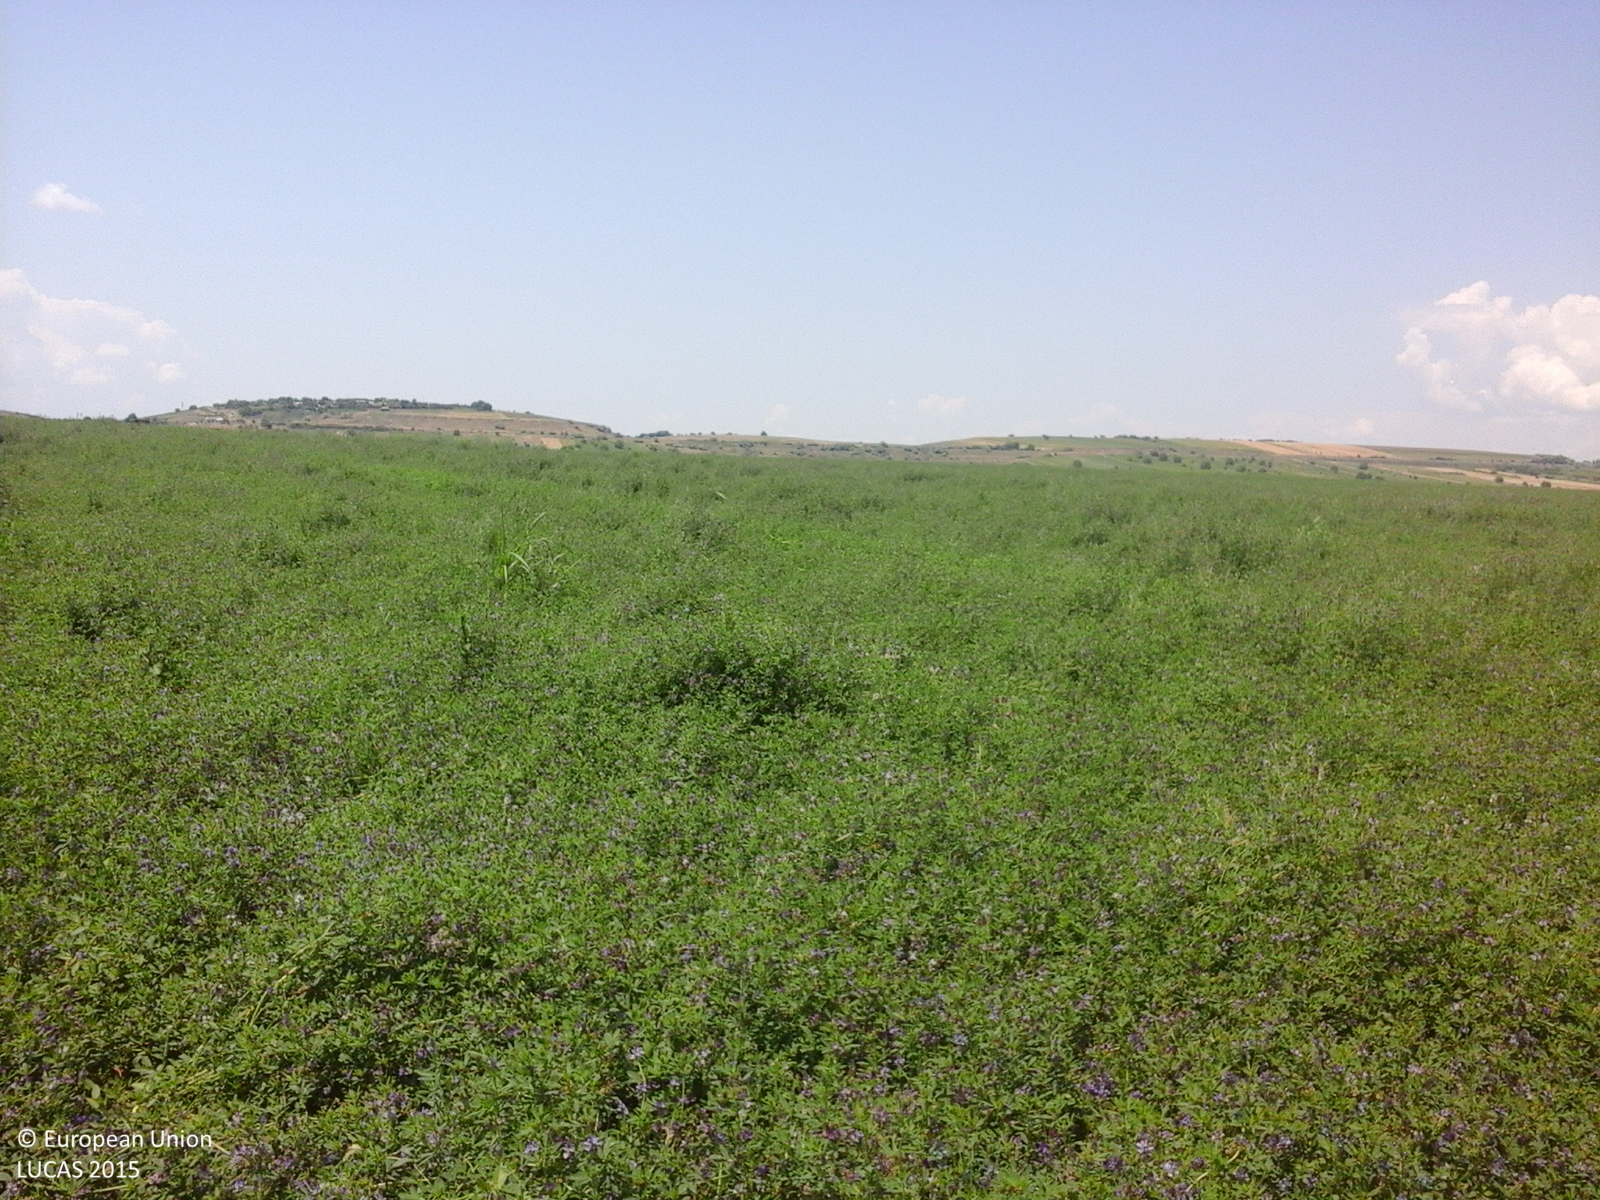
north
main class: Cropland
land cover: Lucerne
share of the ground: > 75 %
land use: Agriculture (excluding fallow land and kitchen gardens)
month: July
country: RO
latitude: 43.9954
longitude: 26.0227
